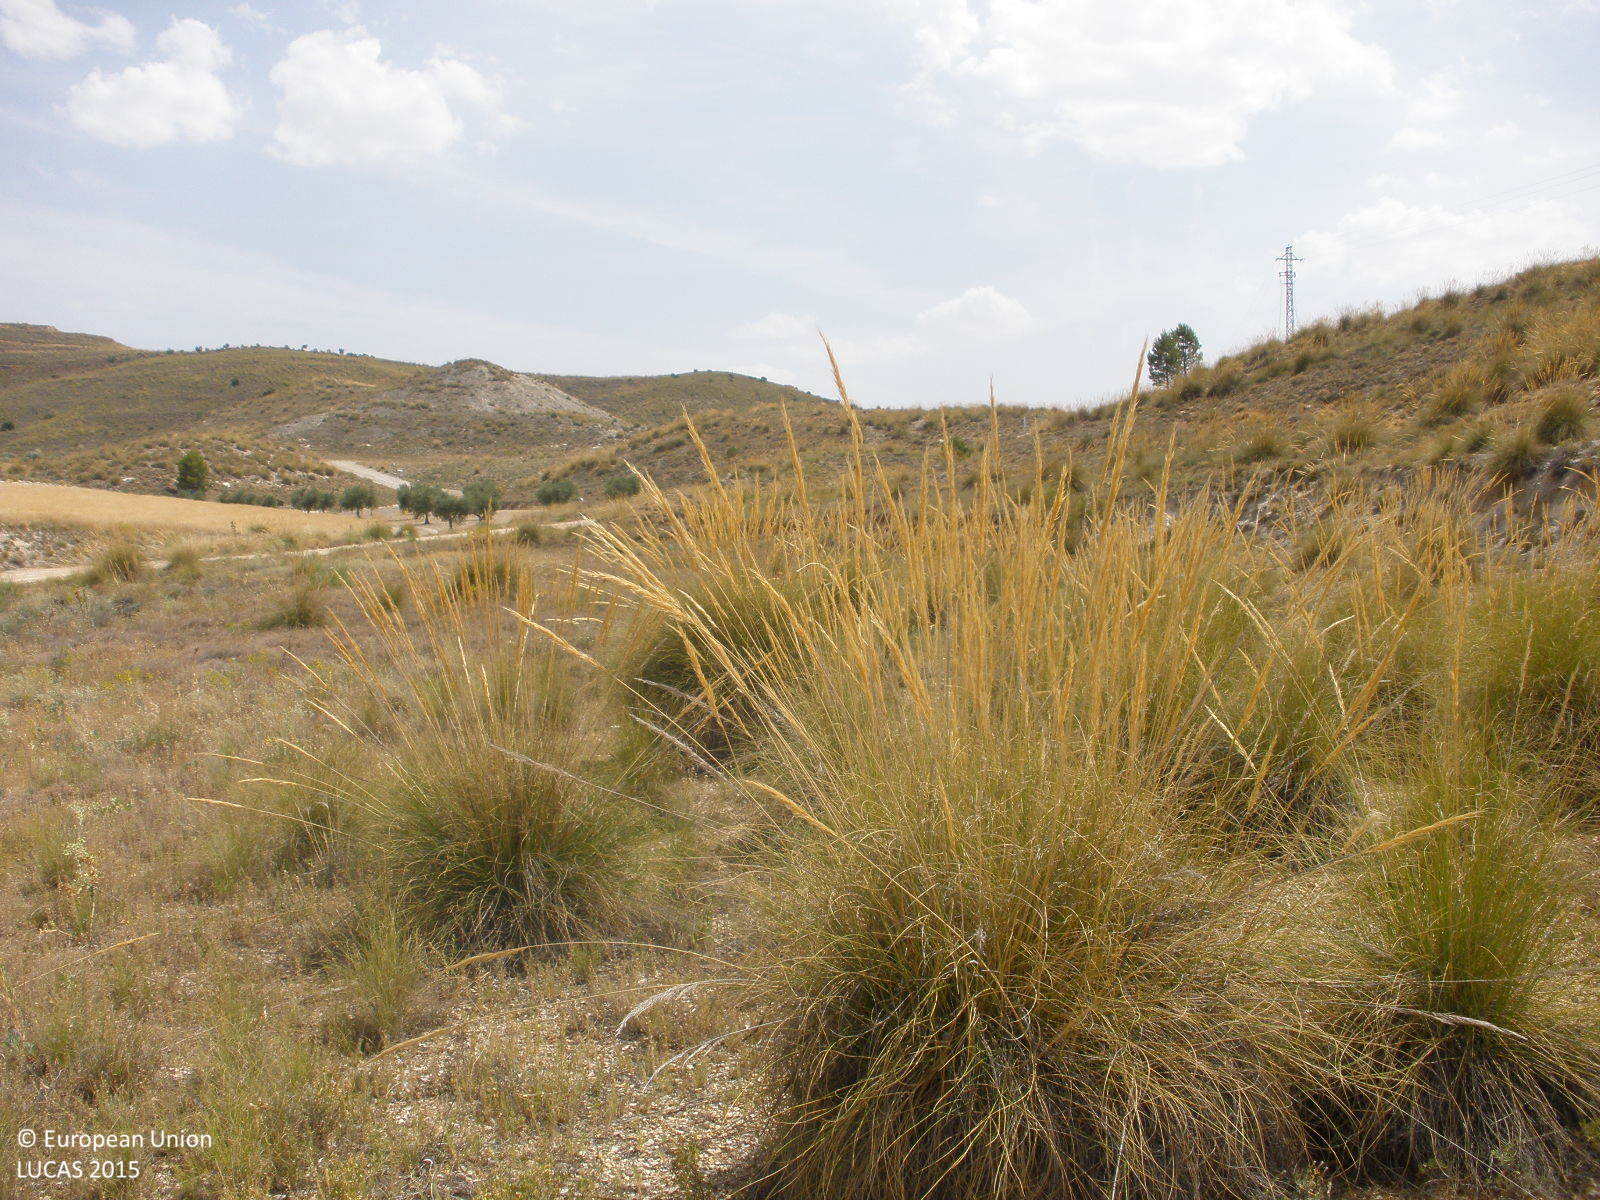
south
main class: Shrubland
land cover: Shrubland without tree cover
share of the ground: 10 - 25 %
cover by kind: herbaceous plants 70 %, shrubs 15 %, consolidated bare surface 15 %
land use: Semi-natural and natural areas not in use
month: July
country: ES
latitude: 40.1815
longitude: -3.4314
